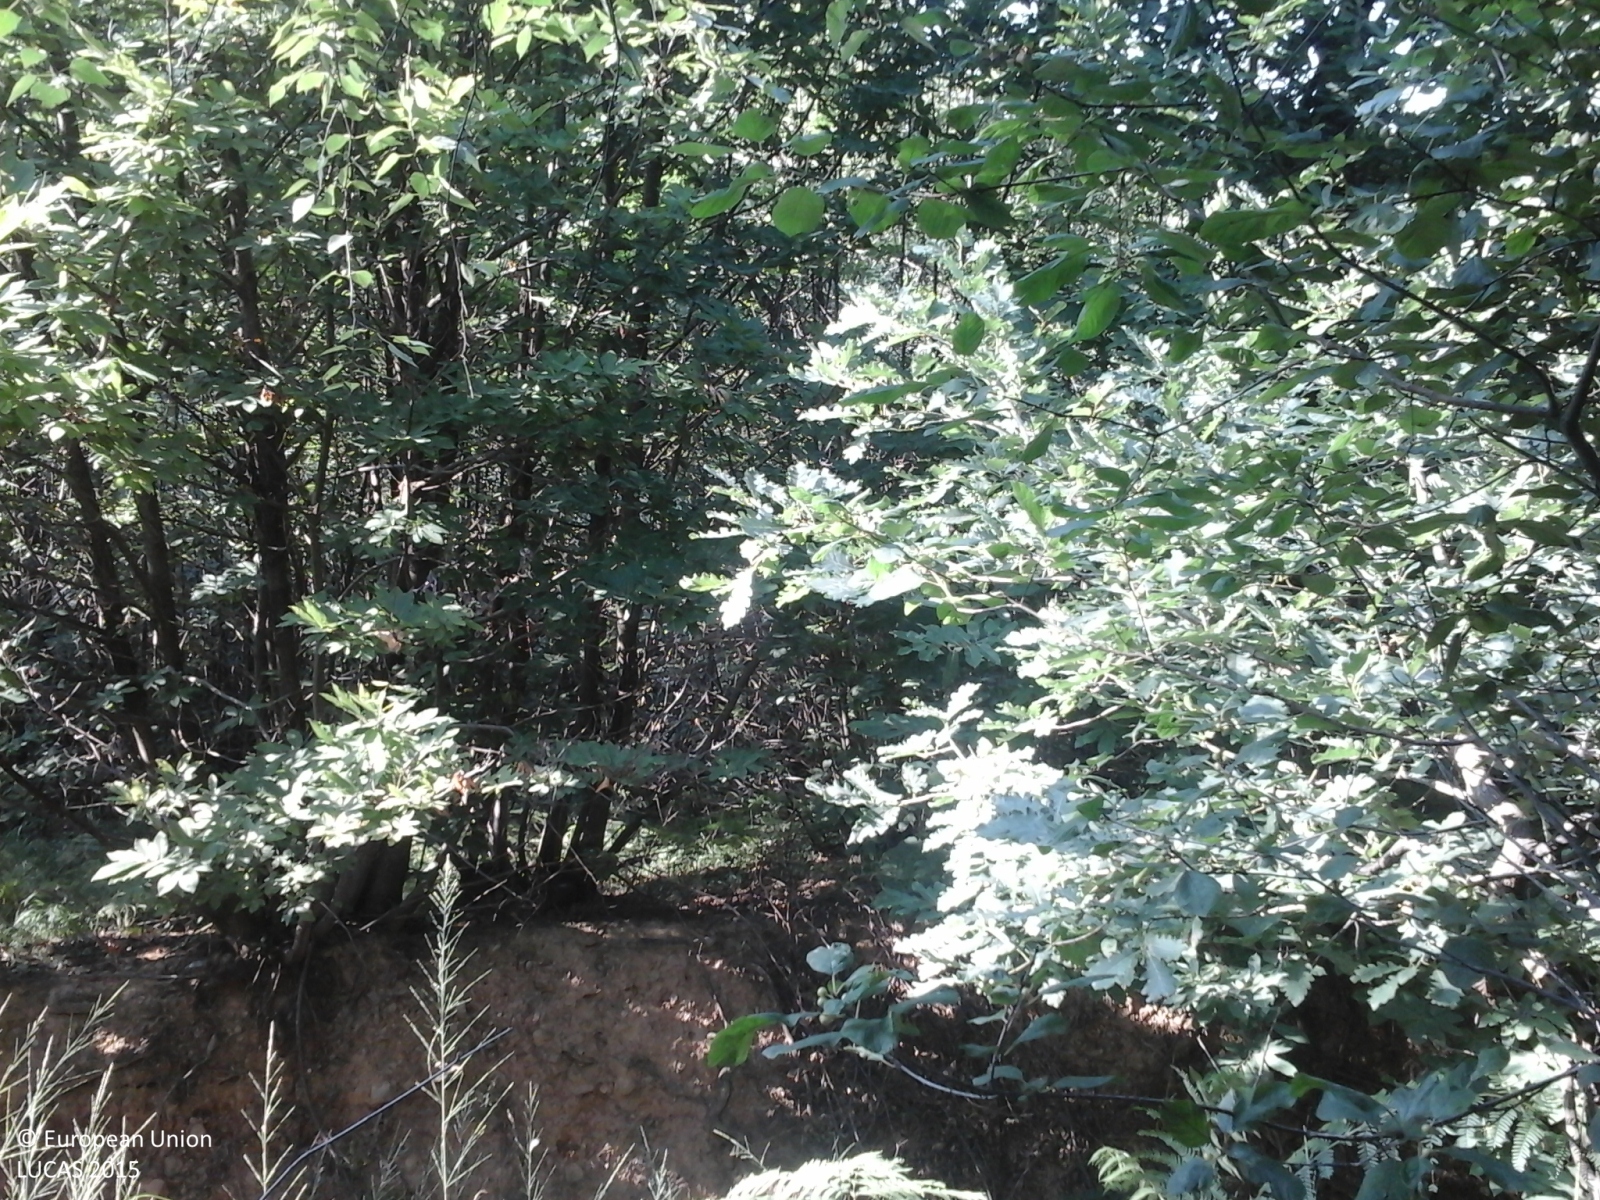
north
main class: Woodland
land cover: Broadleaved woodland
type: thermophilous deciduous forest
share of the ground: > 75 %
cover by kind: broadleaved forest trees 100 %
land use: Semi-natural and natural areas not in use
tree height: > 5 m
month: July
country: IT
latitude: 44.8563
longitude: 7.2842
